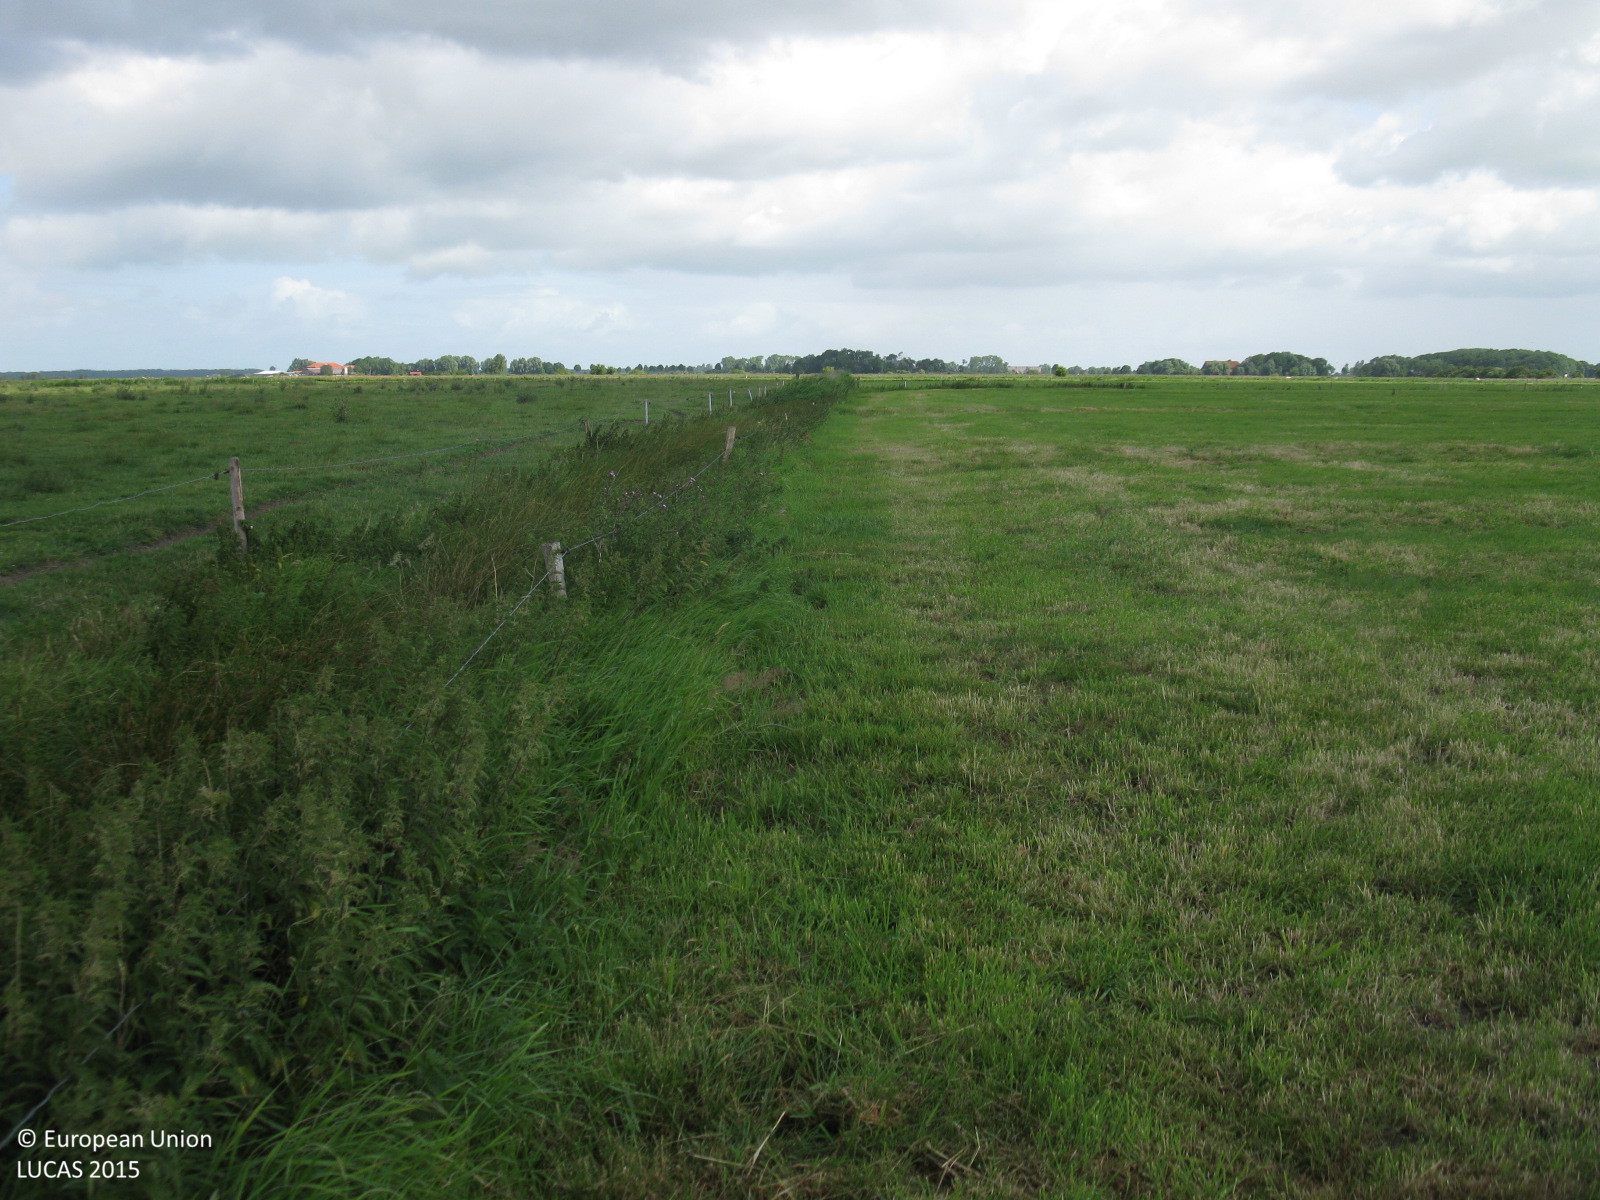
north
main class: Grassland
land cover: Grassland without tree/shrub cover
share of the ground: > 75 %
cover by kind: herbaceous plants 100 %
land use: Agriculture (excluding fallow land and kitchen gardens)
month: July
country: DE
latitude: 53.4743
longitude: 7.9366
